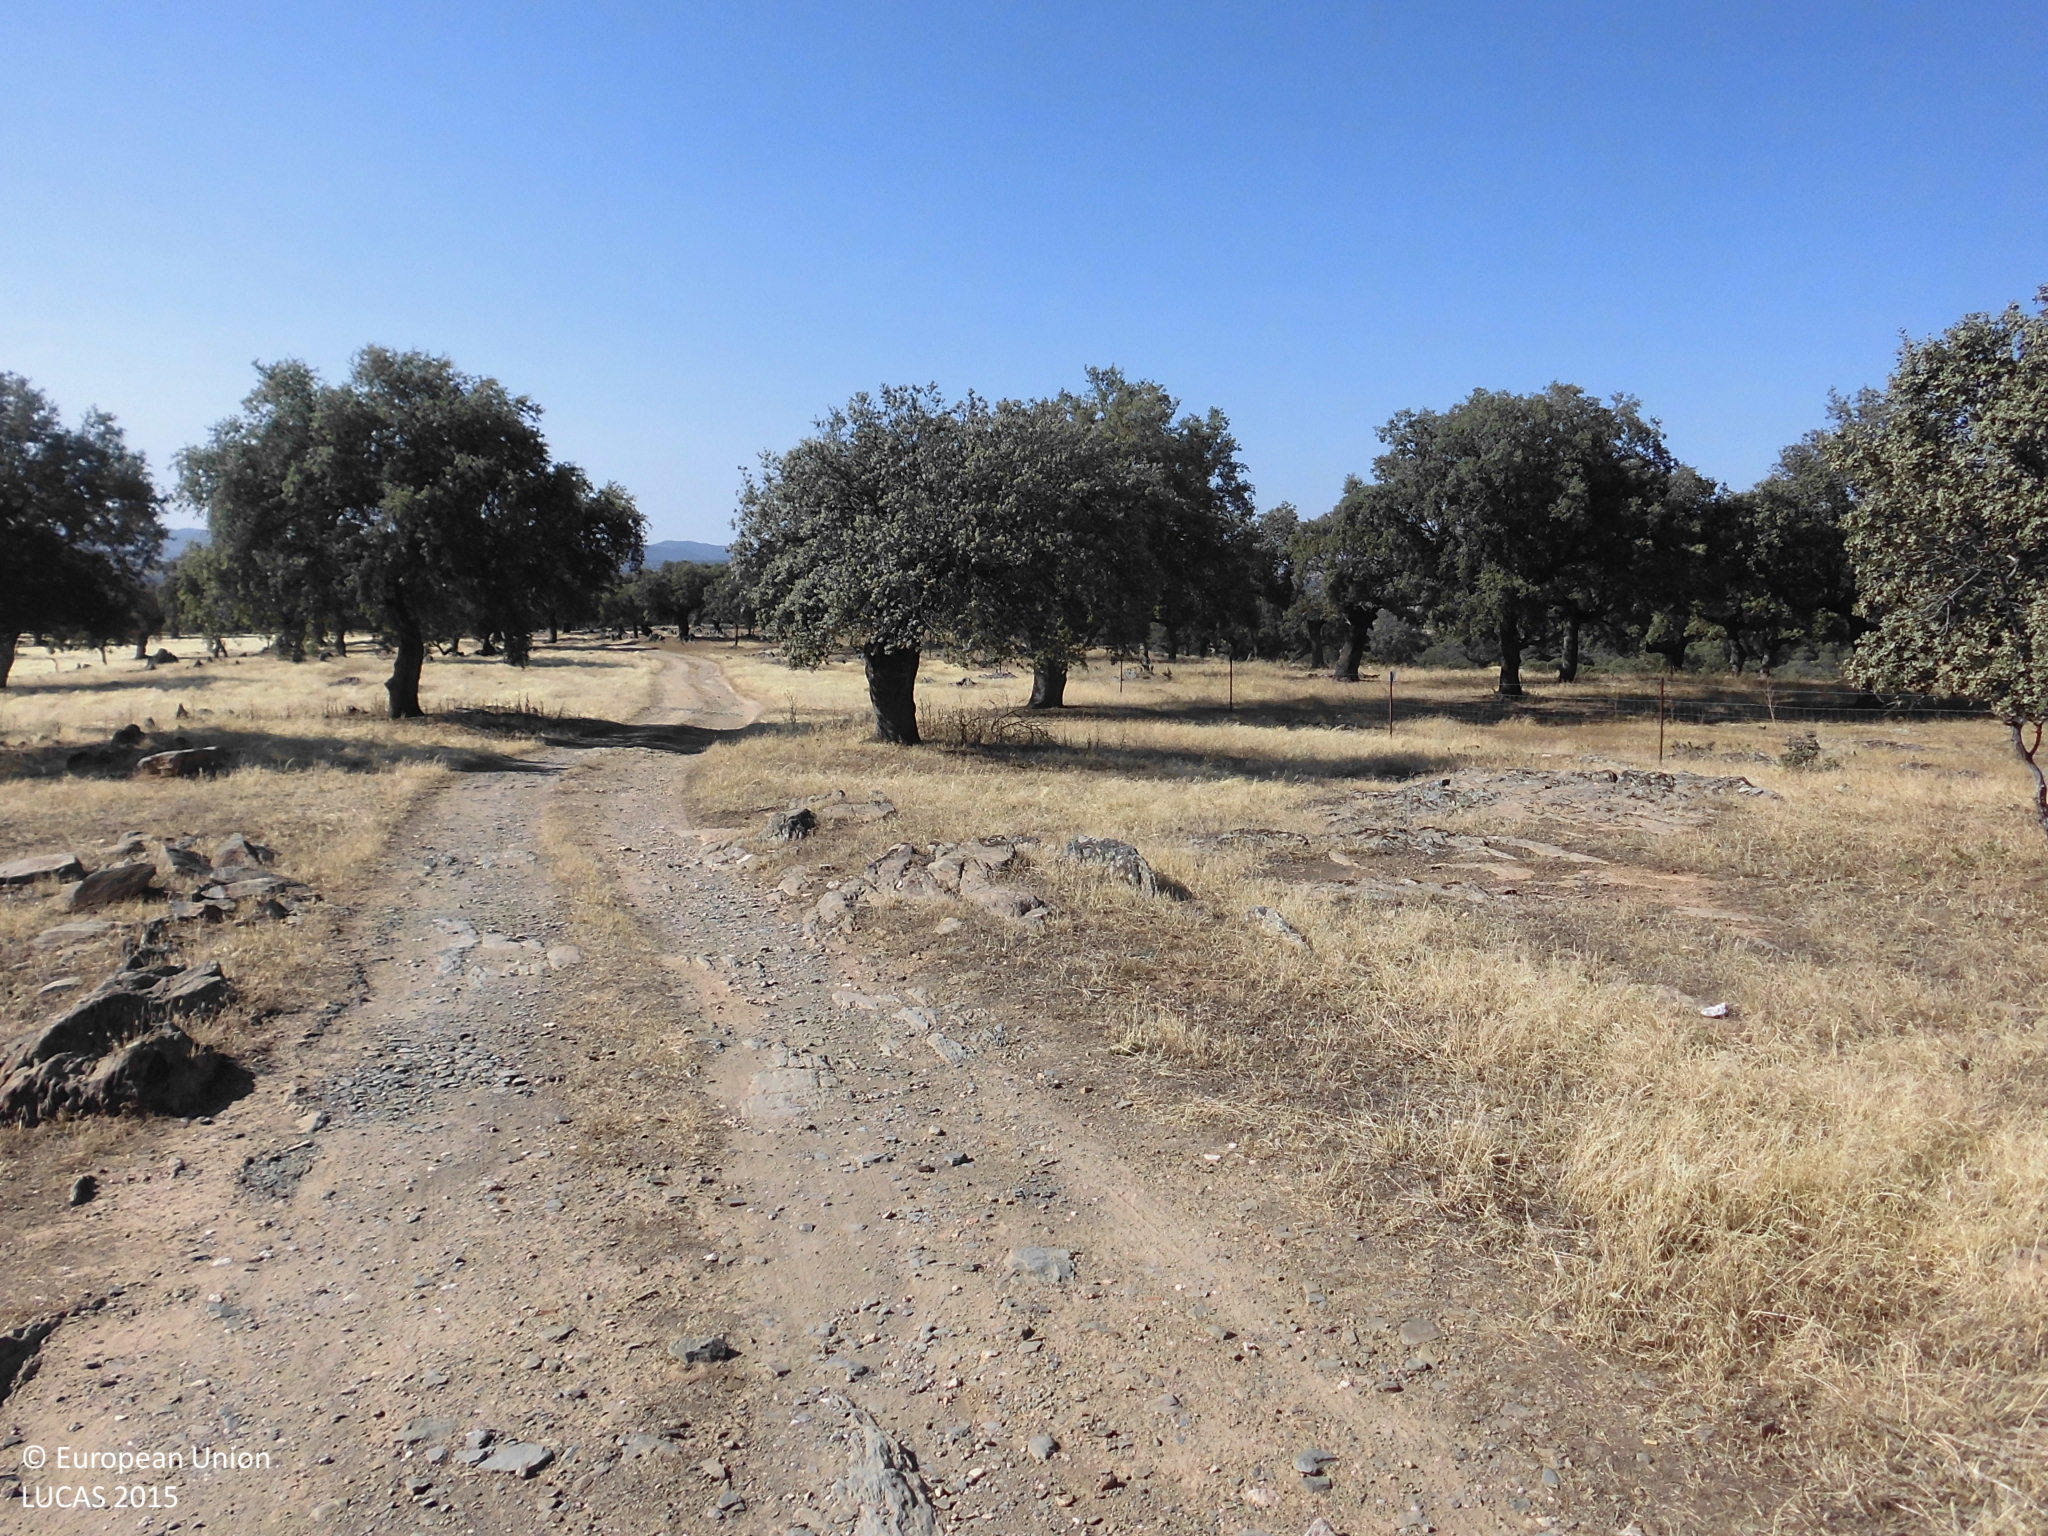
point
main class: Woodland
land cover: Broadleaved woodland
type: broadleaved evergreen forest
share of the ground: 10 - 25 %
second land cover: Grassland without tree/shrub cover
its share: > 75 %
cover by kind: herbaceous plants 80 %, broadleaved forest trees 20 %
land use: Forestry
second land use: Agriculture (excluding fallow land and kitchen gardens)
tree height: > 5 m
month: July
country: ES
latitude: 39.5636
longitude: -5.5934
